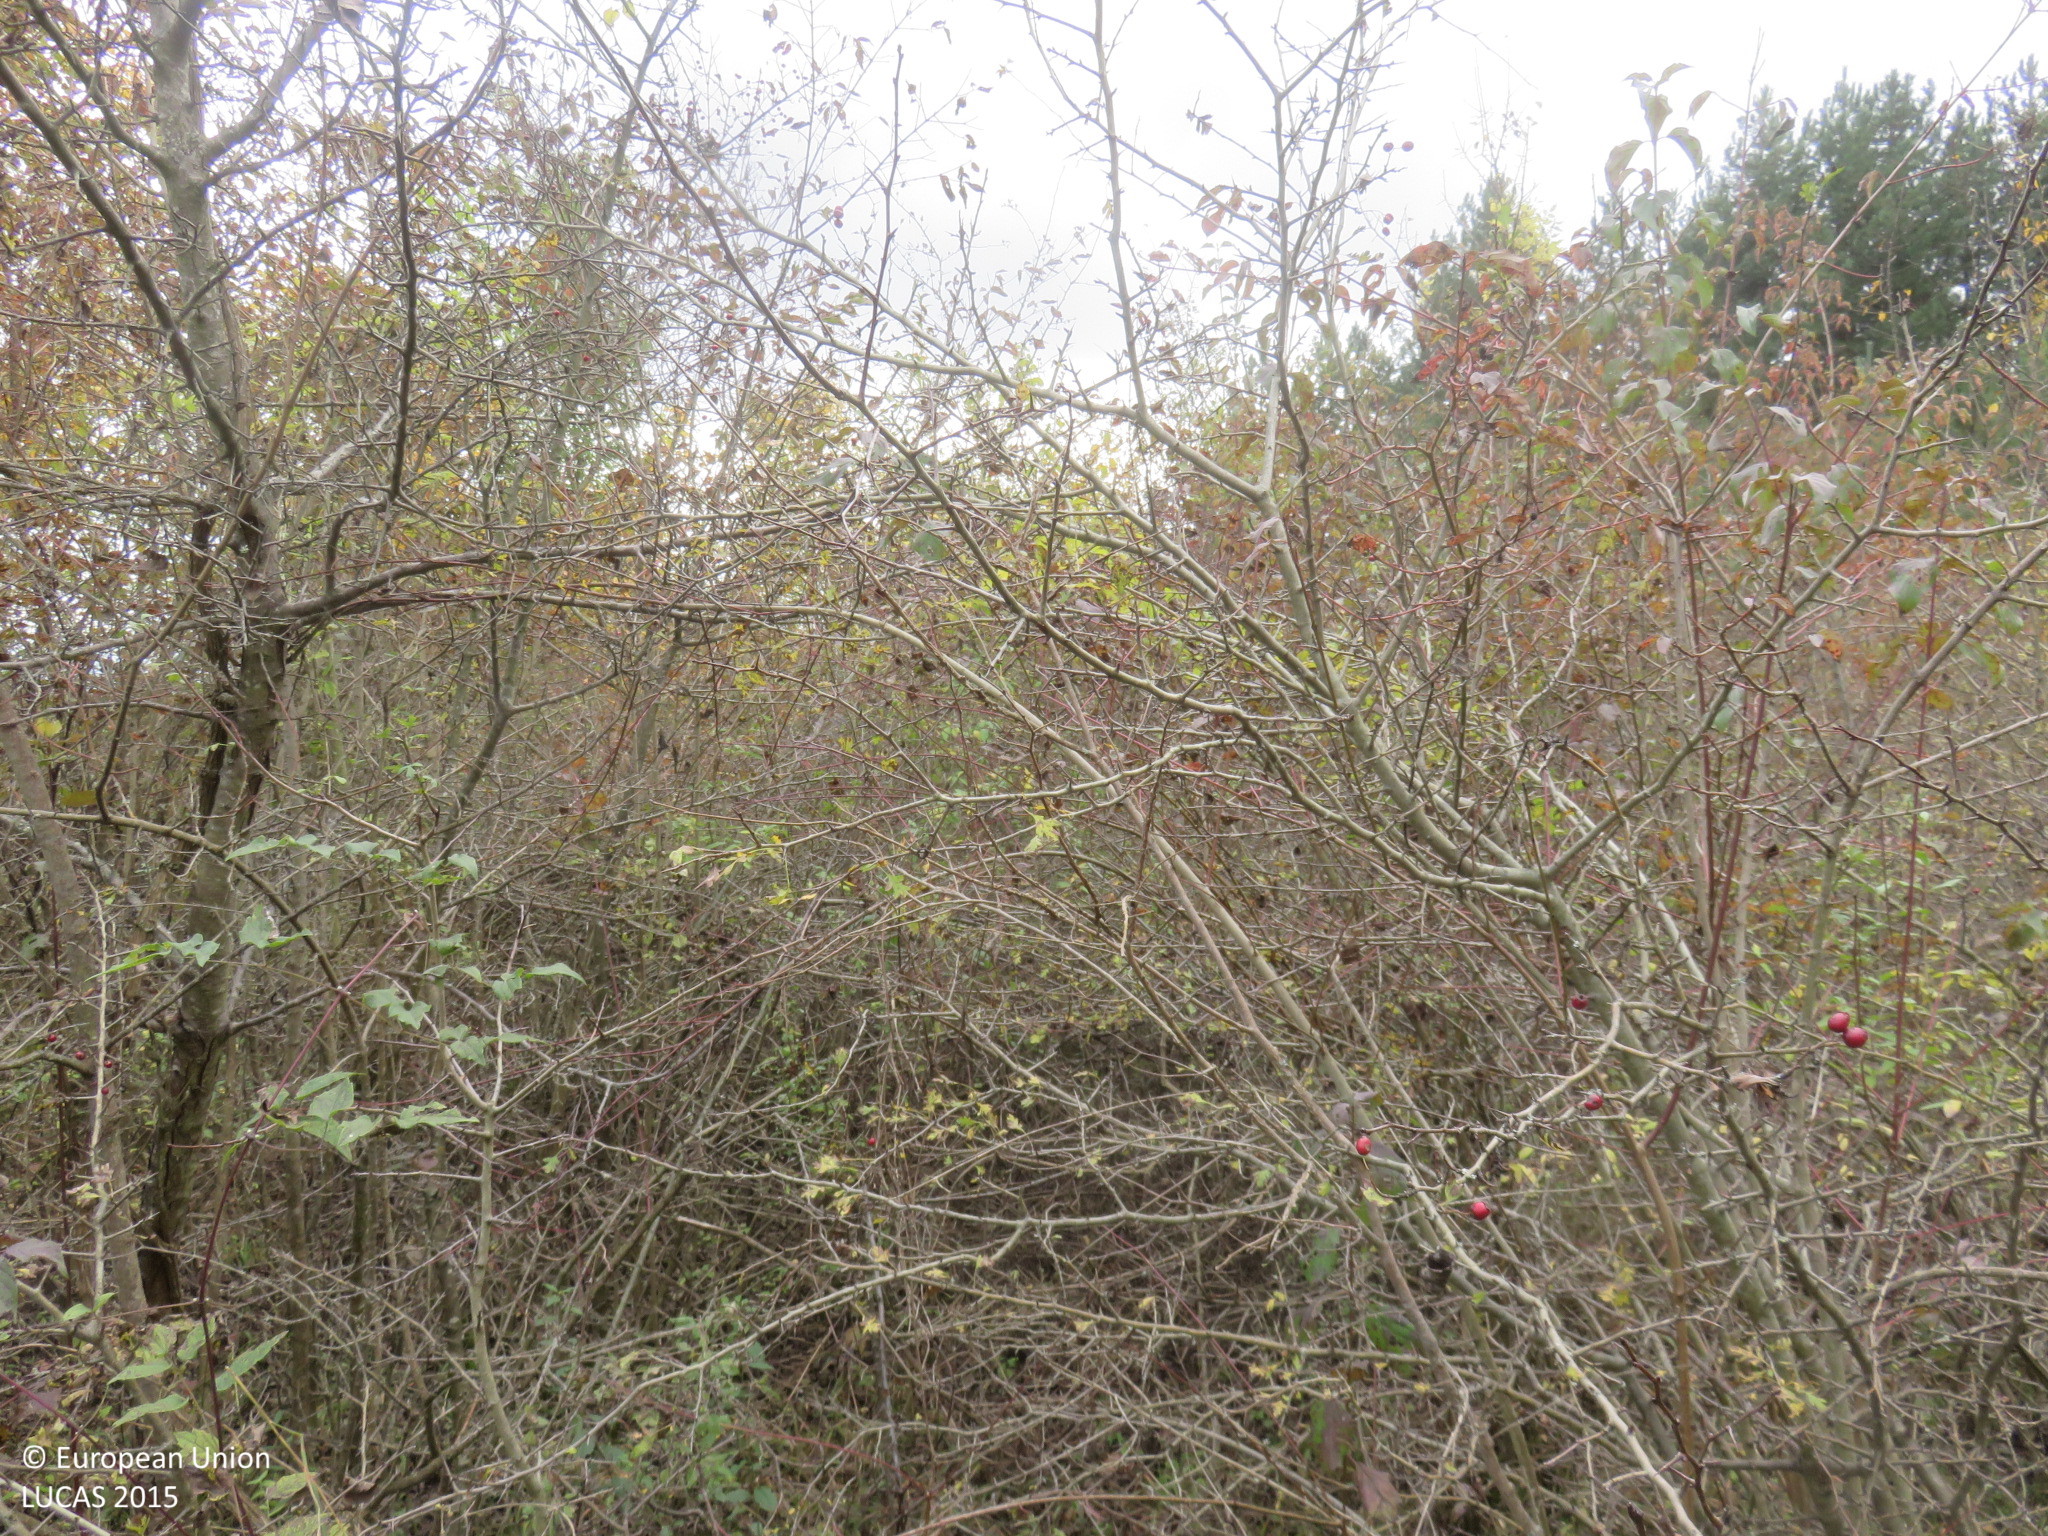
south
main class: Shrubland
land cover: Shrubland with sparse tree cover
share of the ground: > 75 %
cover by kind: shrubs 85 %, herbaceous plants 10 %, broadleaved forest trees 5 %
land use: Semi-natural and natural areas not in use
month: October
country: BG
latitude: 42.9973
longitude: 24.9936
